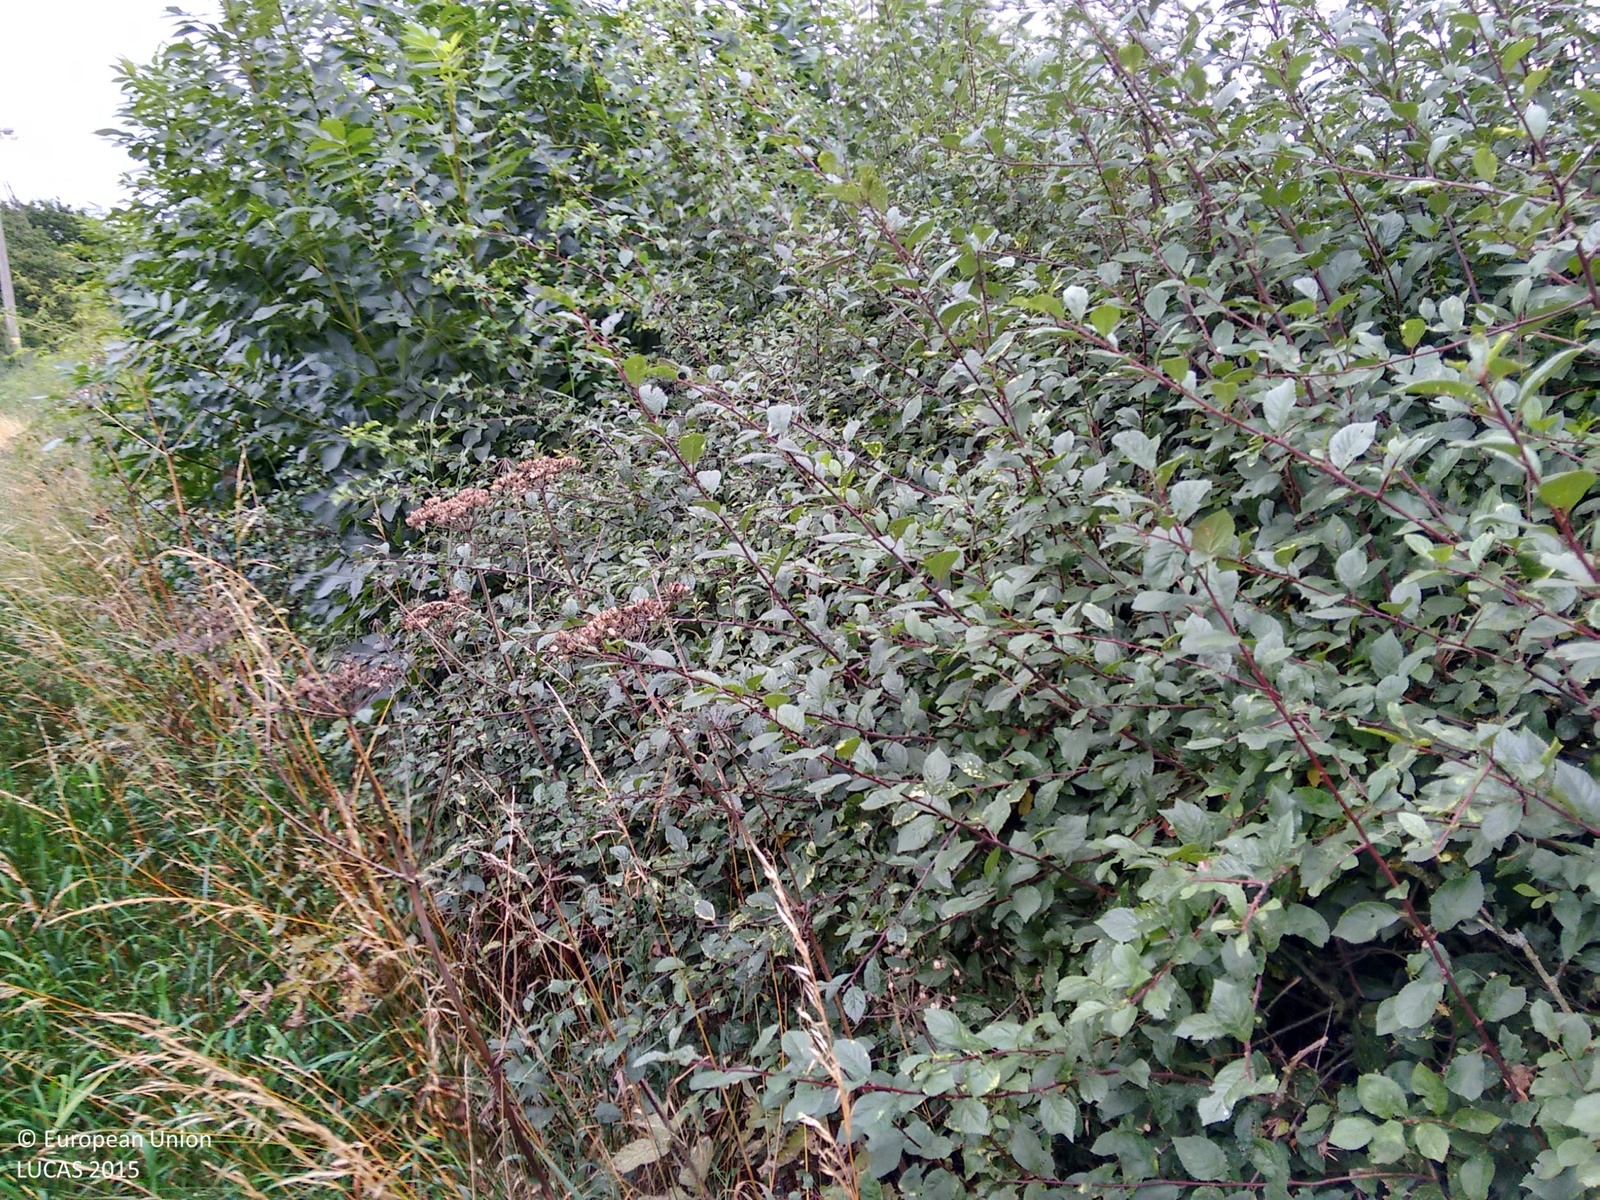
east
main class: Cropland
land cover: Maize
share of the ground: > 75 %
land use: Agriculture (excluding fallow land and kitchen gardens)
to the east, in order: Maize; Electric lines; Maize; Broadleaved woodland; Grassland without tree/shrub cover; Fences; Grassland with sparse tree/shrub cover
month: August
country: GB
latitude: 52.6655
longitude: -1.3605
